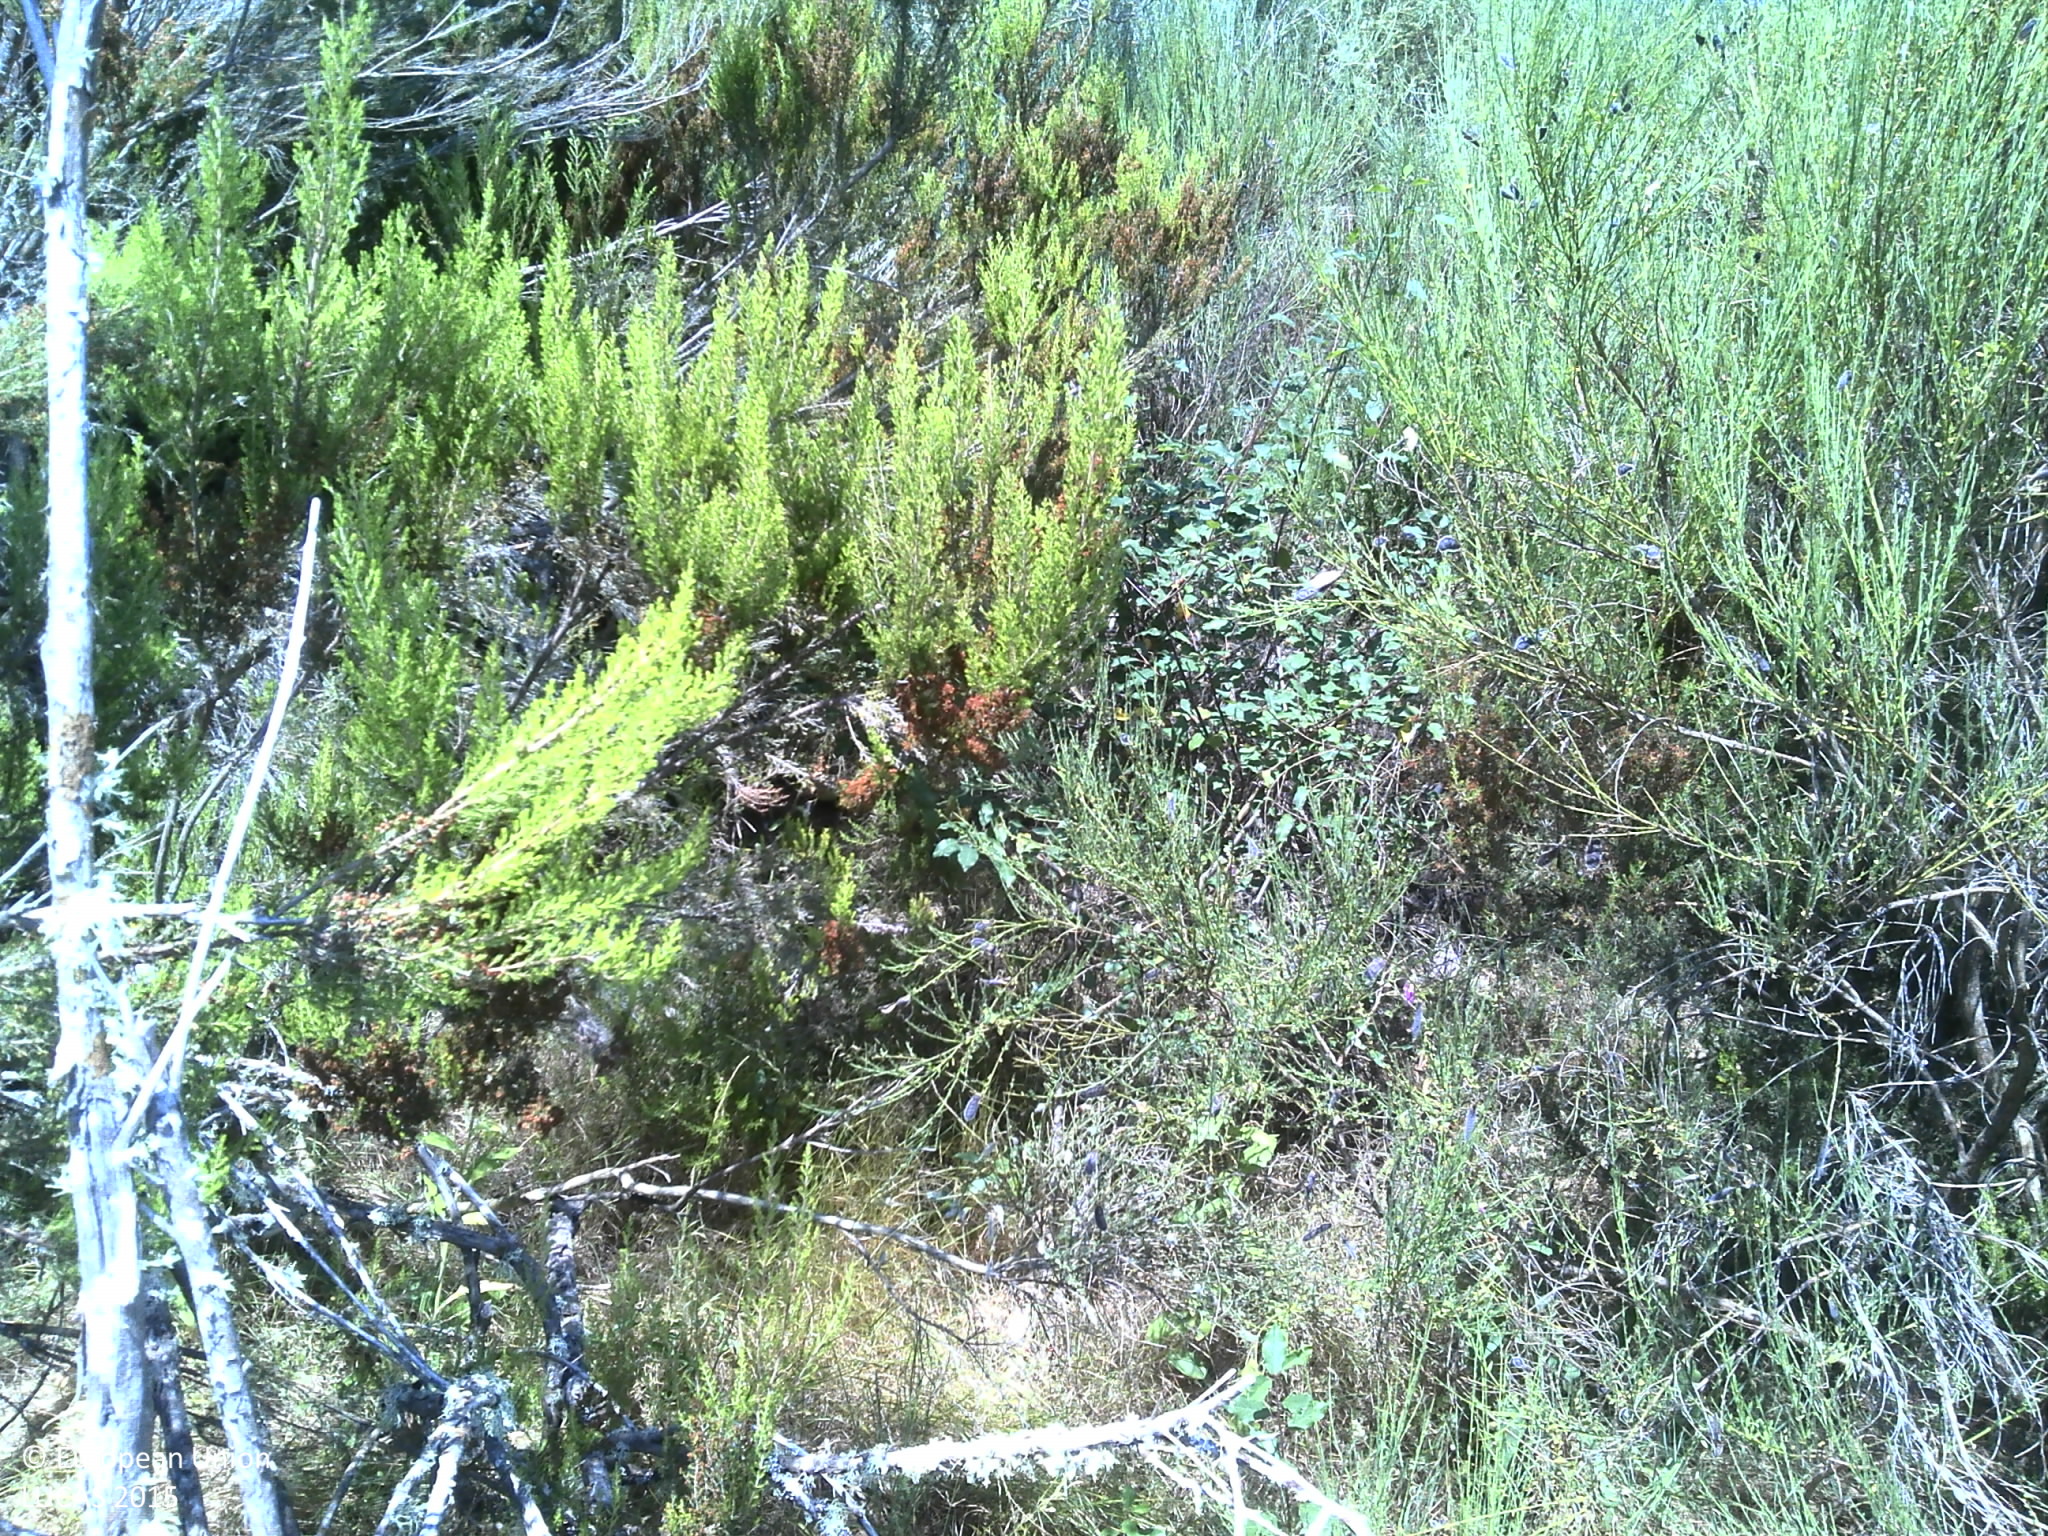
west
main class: Shrubland
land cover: Shrubland without tree cover
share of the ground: > 75 %
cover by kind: shrubs 95 %, herbaceous plants 5 %
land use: Semi-natural and natural areas not in use
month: July
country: PT
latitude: 41.8789
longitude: -7.6703
